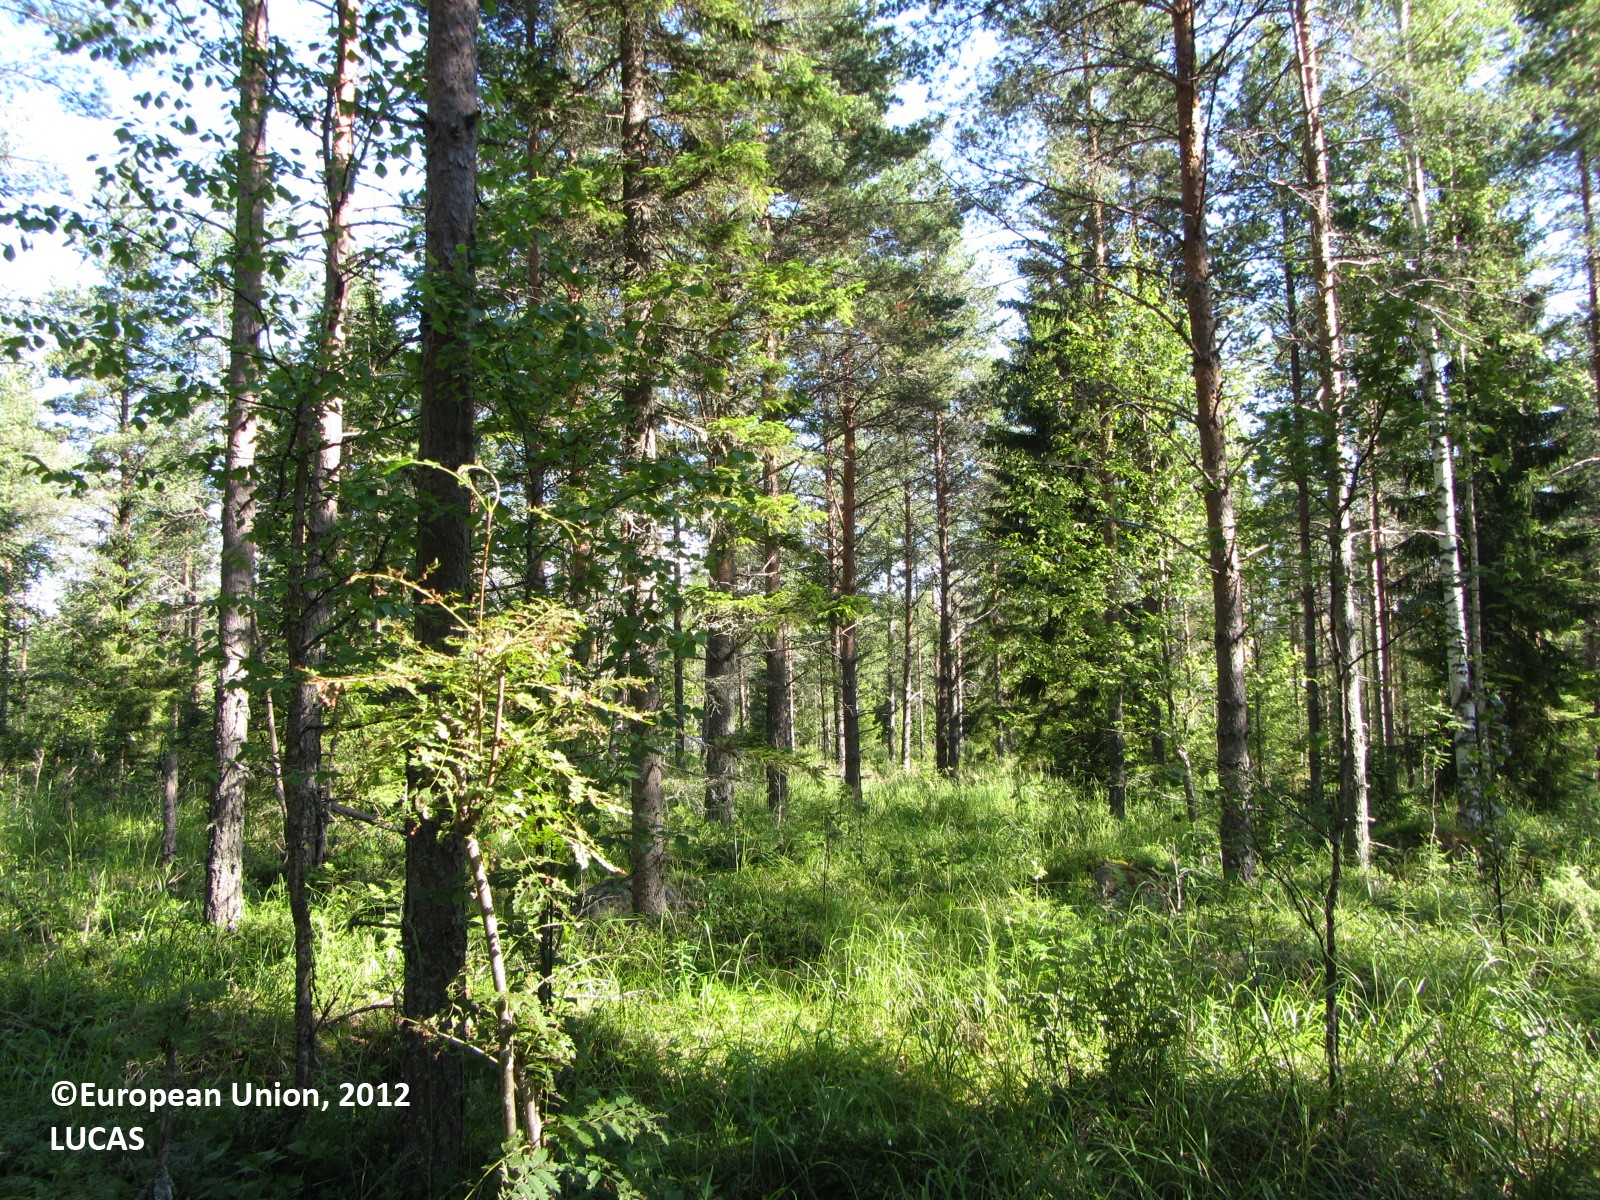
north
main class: Woodland
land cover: Pine dominated coniferous woodland
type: boreal forest
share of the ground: 50 - 75 %
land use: Forestry
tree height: > 5 m
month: July
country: FI
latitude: 63.6370
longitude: 24.6754
